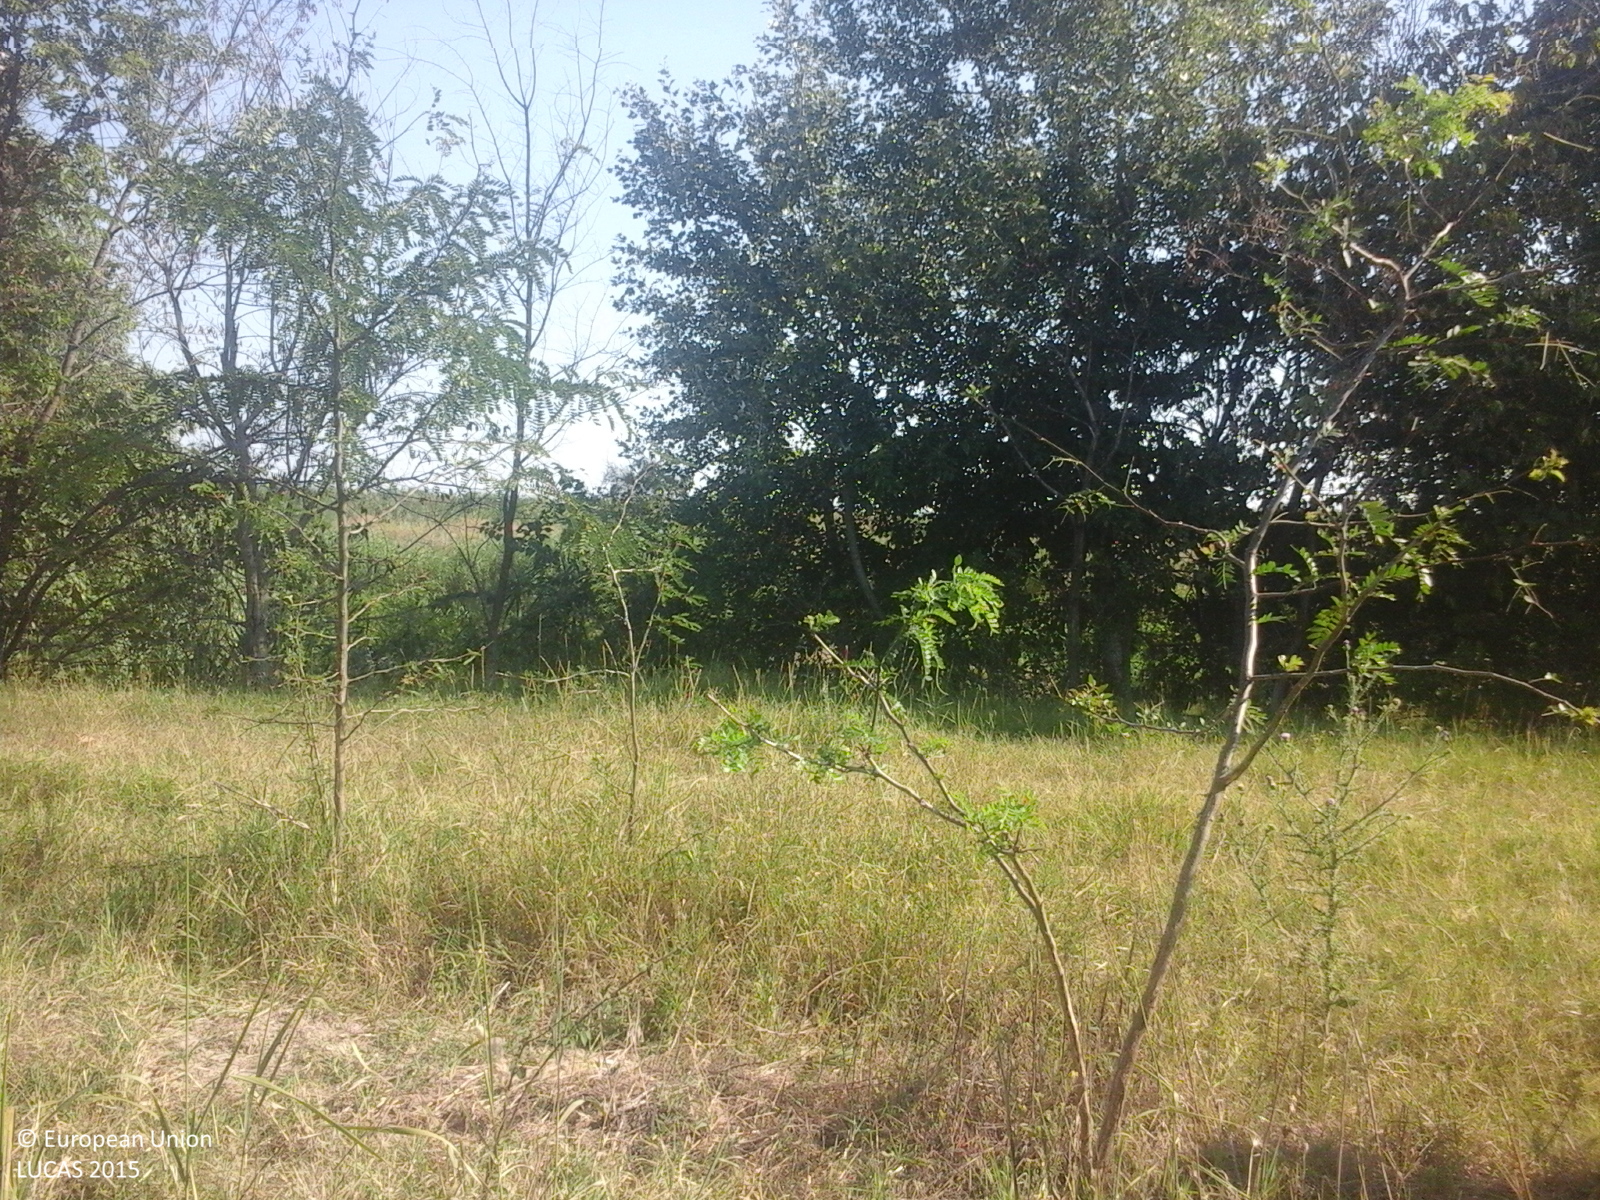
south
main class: Grassland
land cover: Grassland with sparse tree/shrub cover
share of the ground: > 75 %
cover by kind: herbaceous plants 90 %, broadleaved forest trees 5 %, shrubs 5 %
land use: Agriculture (excluding fallow land and kitchen gardens)
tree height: < 5 m
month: July
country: RO
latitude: 44.6319
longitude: 27.6320
